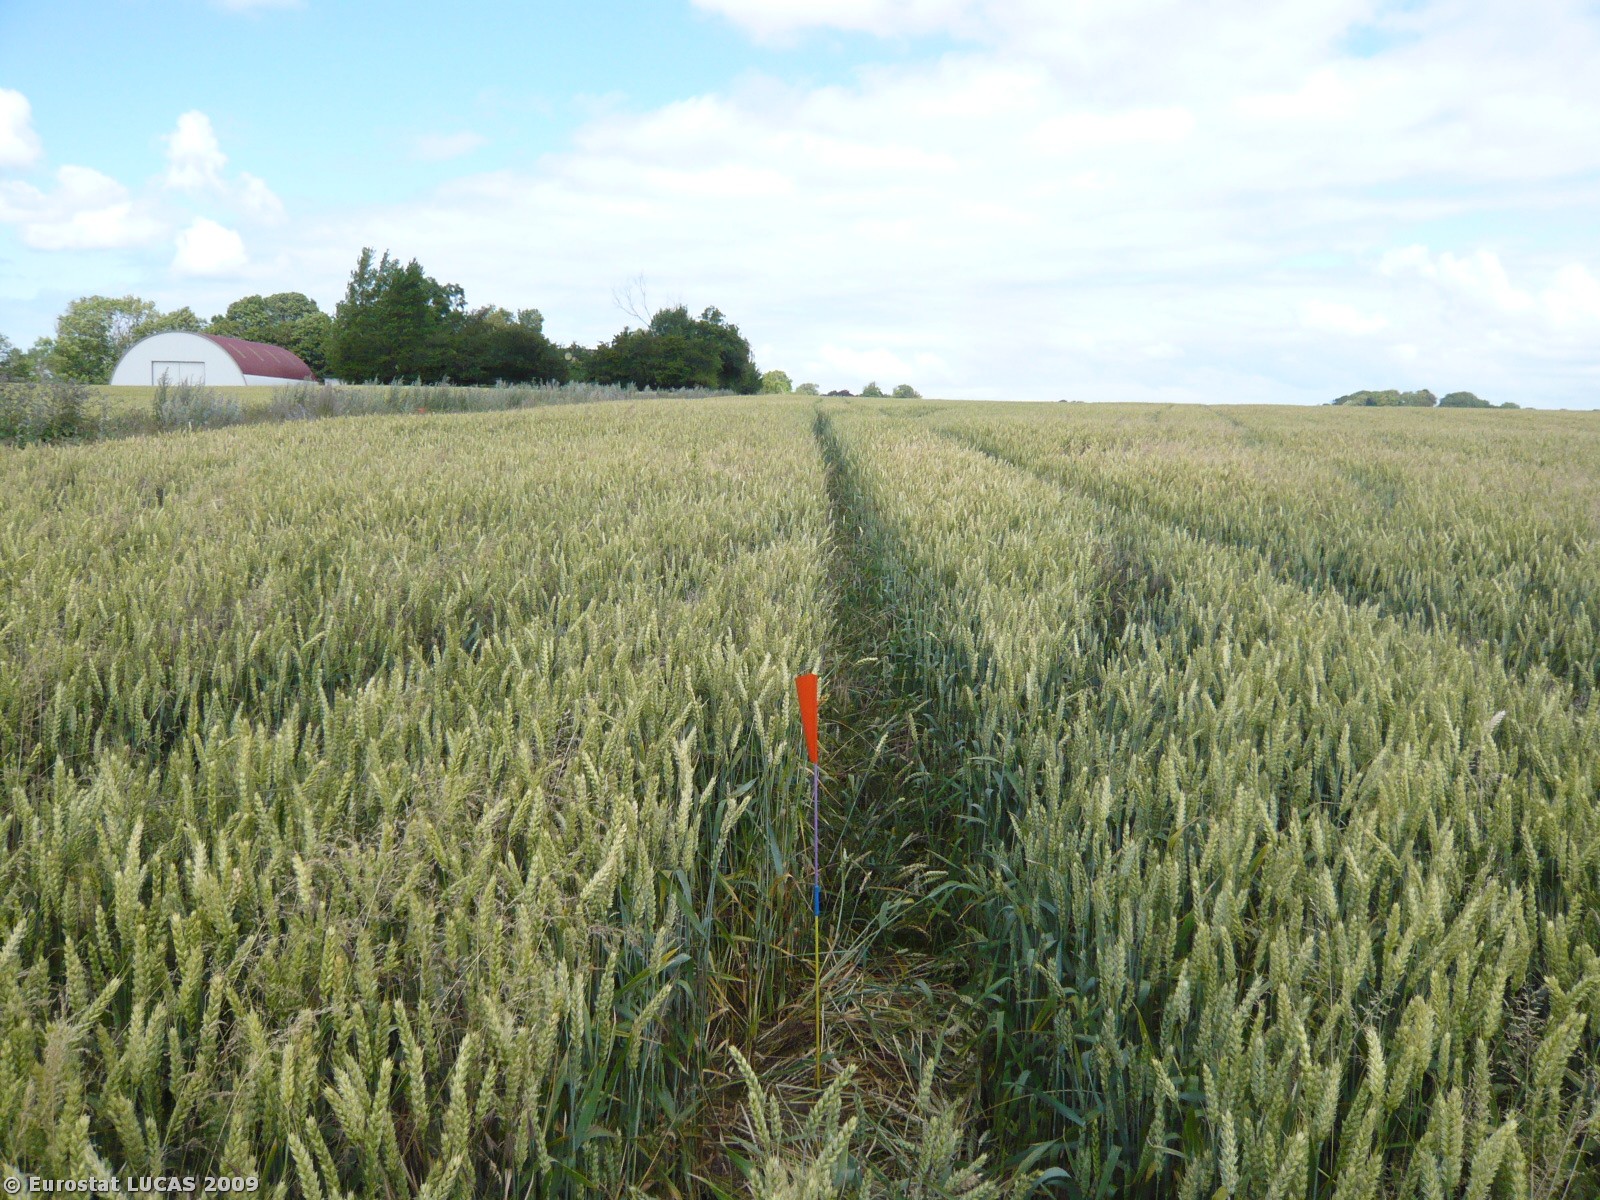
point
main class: Cropland
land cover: Common wheat
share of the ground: > 75 %
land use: Agriculture (excluding fallow land and kitchen gardens)
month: July
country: DK
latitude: 55.6612
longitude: 11.1593
